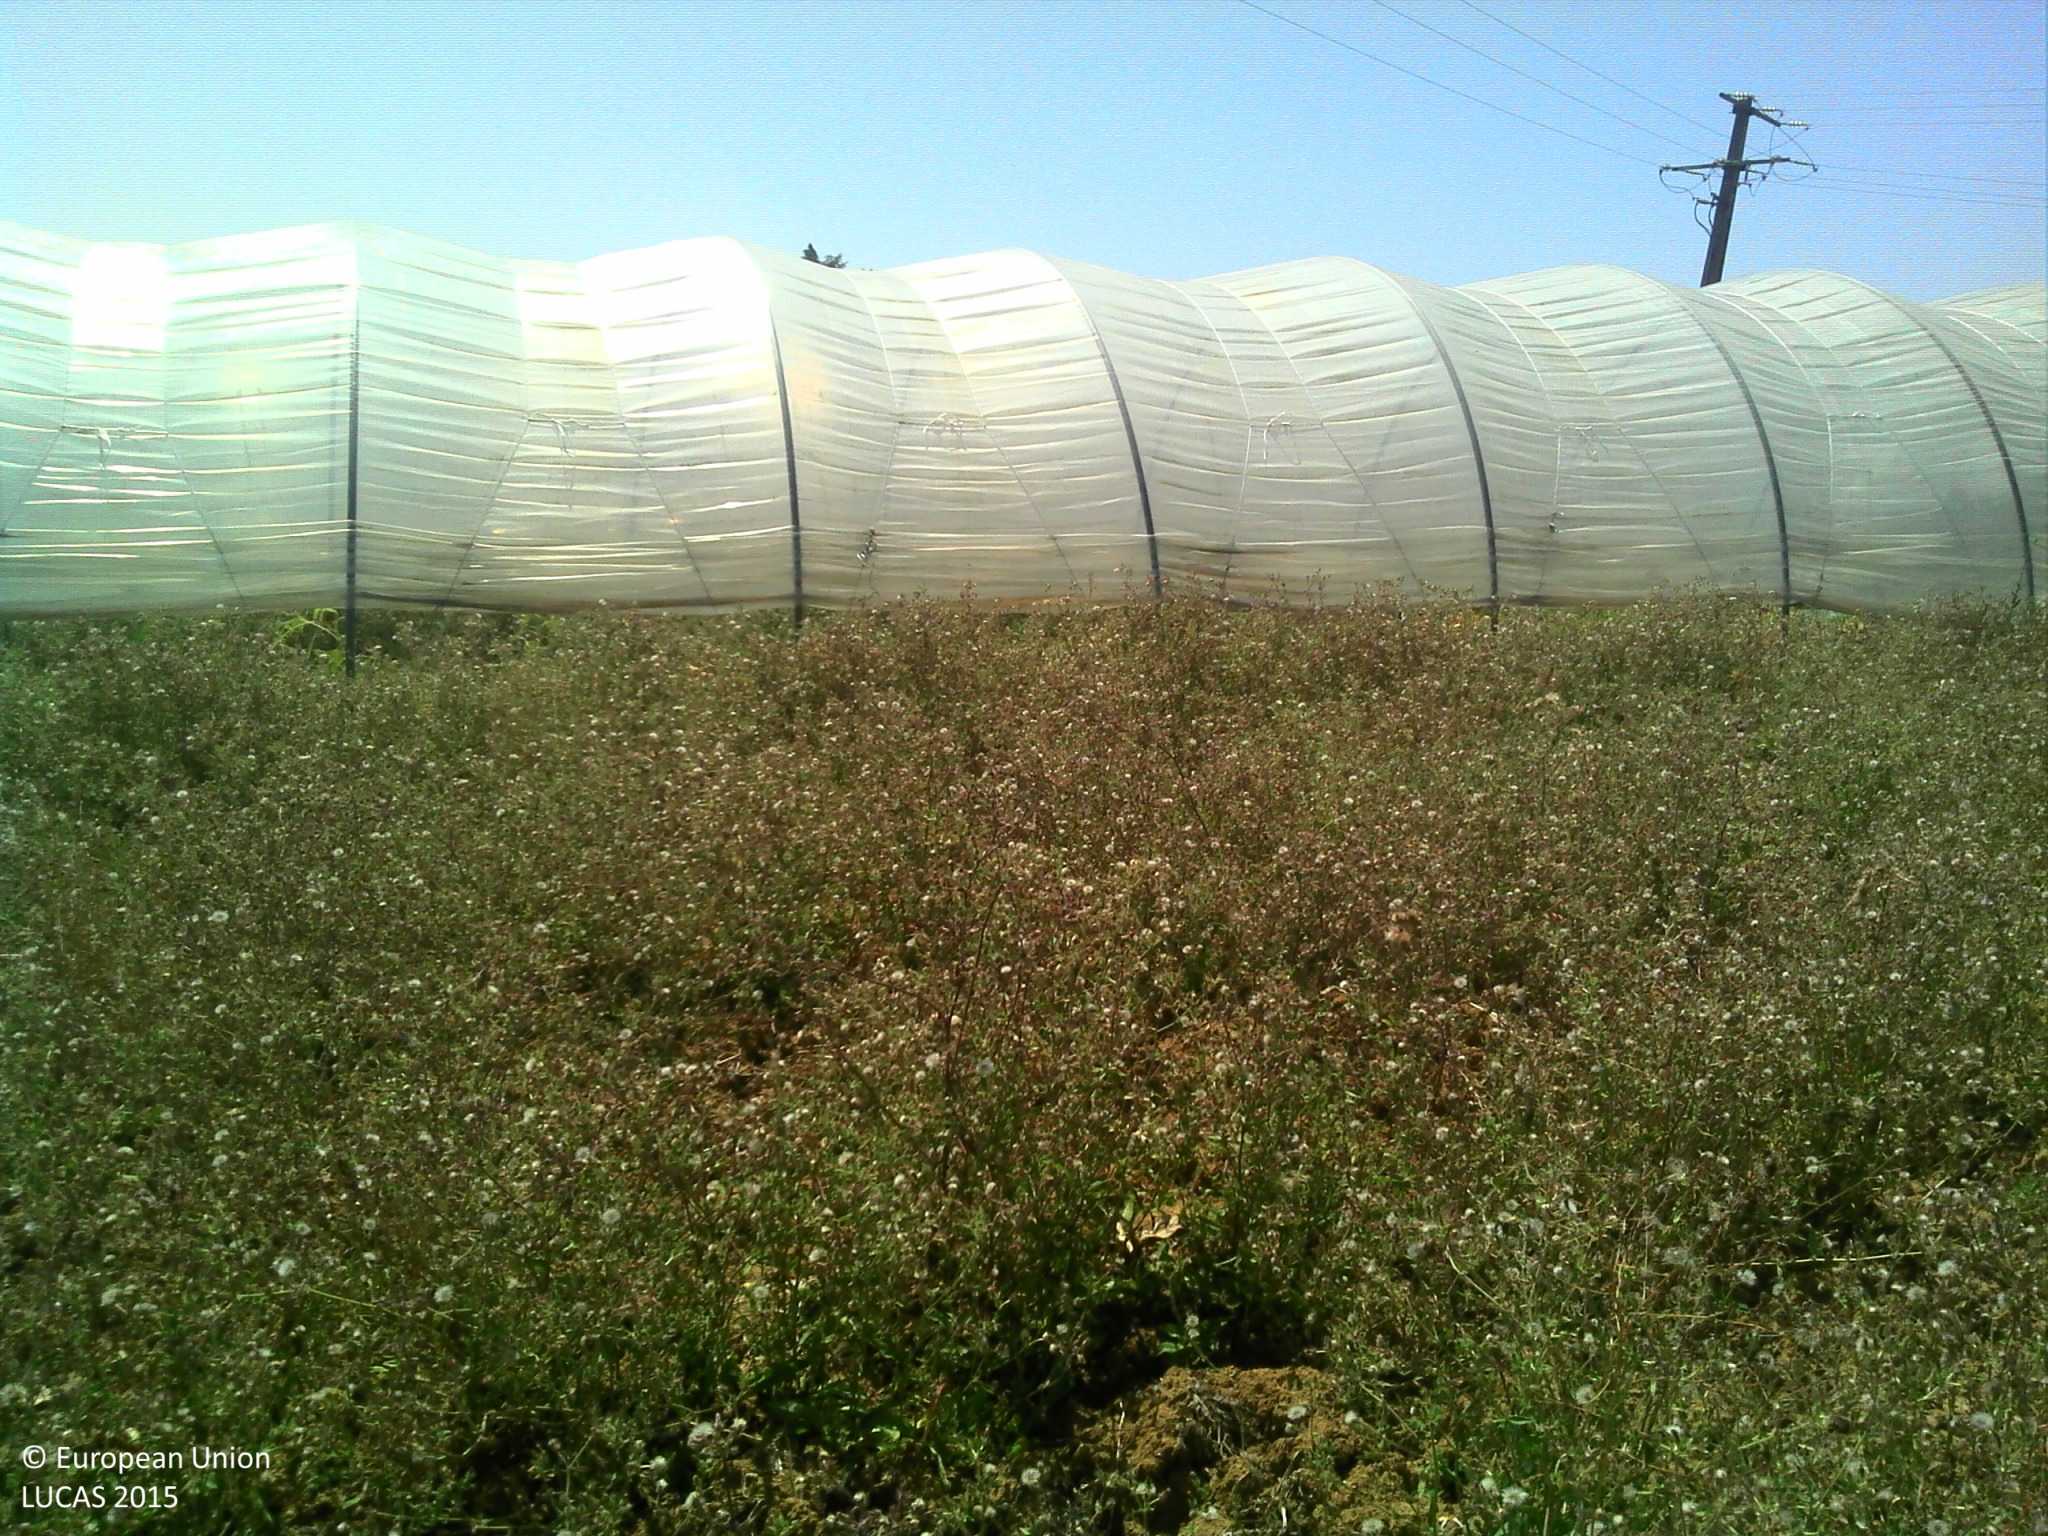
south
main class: Grassland
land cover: Spontaneously vegetated surfaces
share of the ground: > 75 %
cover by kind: herbaceous plants 100 %
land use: Agriculture (excluding fallow land and kitchen gardens)
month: August
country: FR
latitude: 44.2203
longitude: 1.2991
